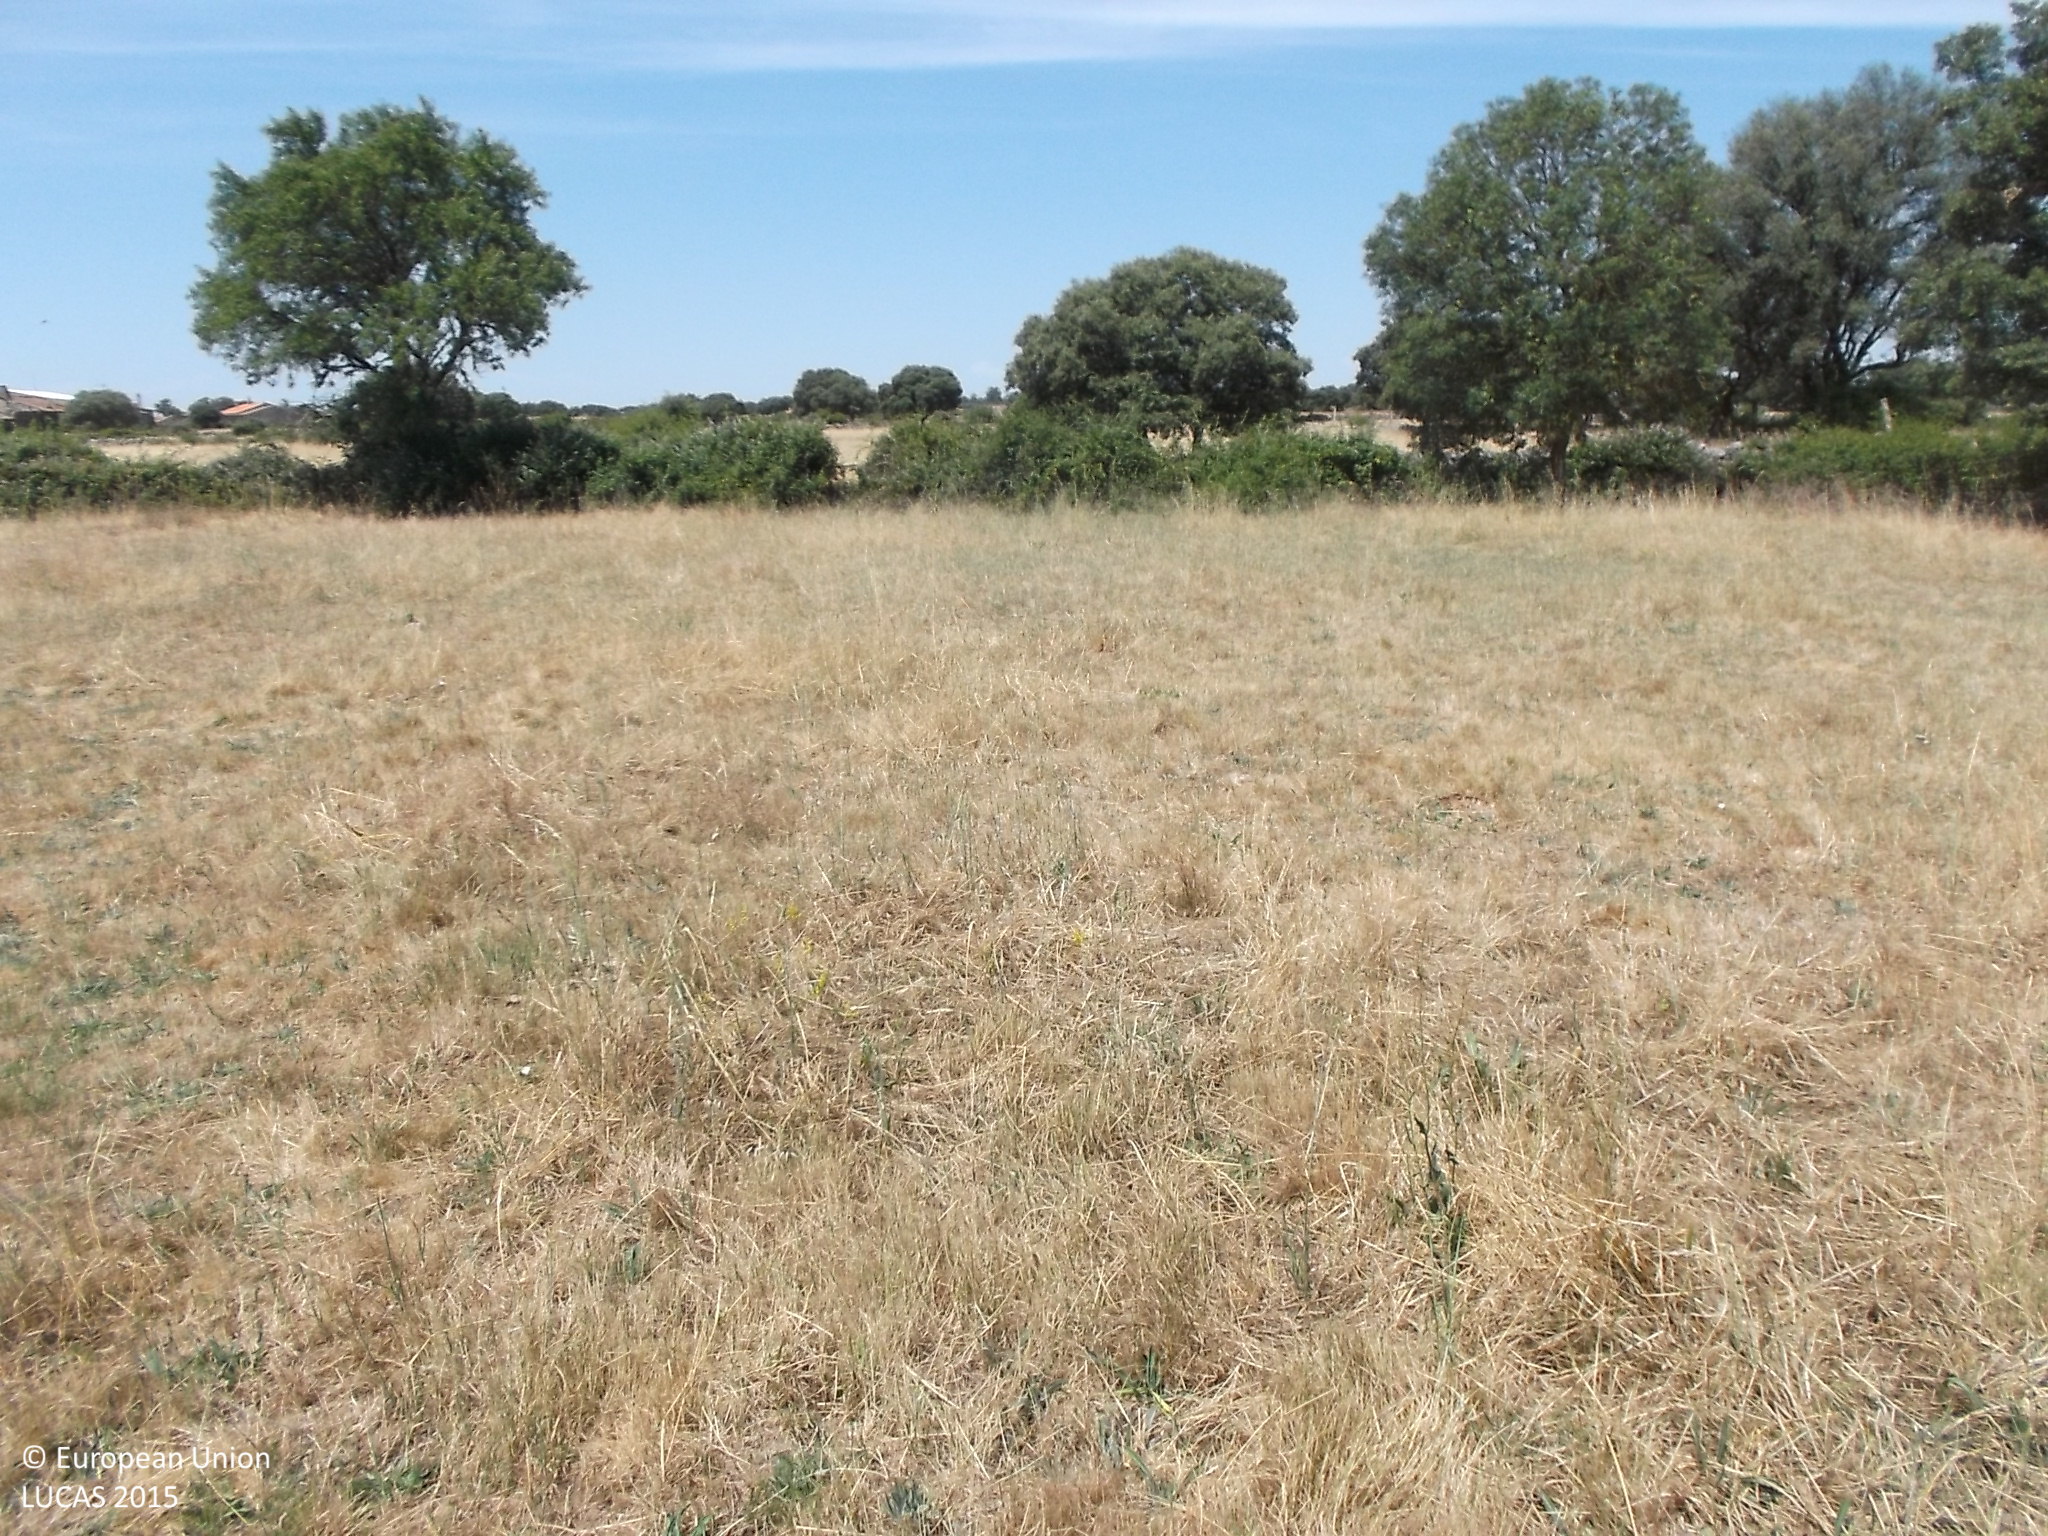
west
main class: Grassland
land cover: Grassland without tree/shrub cover
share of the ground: > 75 %
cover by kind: herbaceous plants 100 %
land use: Agriculture (excluding fallow land and kitchen gardens)
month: June
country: ES
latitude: 41.2624
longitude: -5.9989
